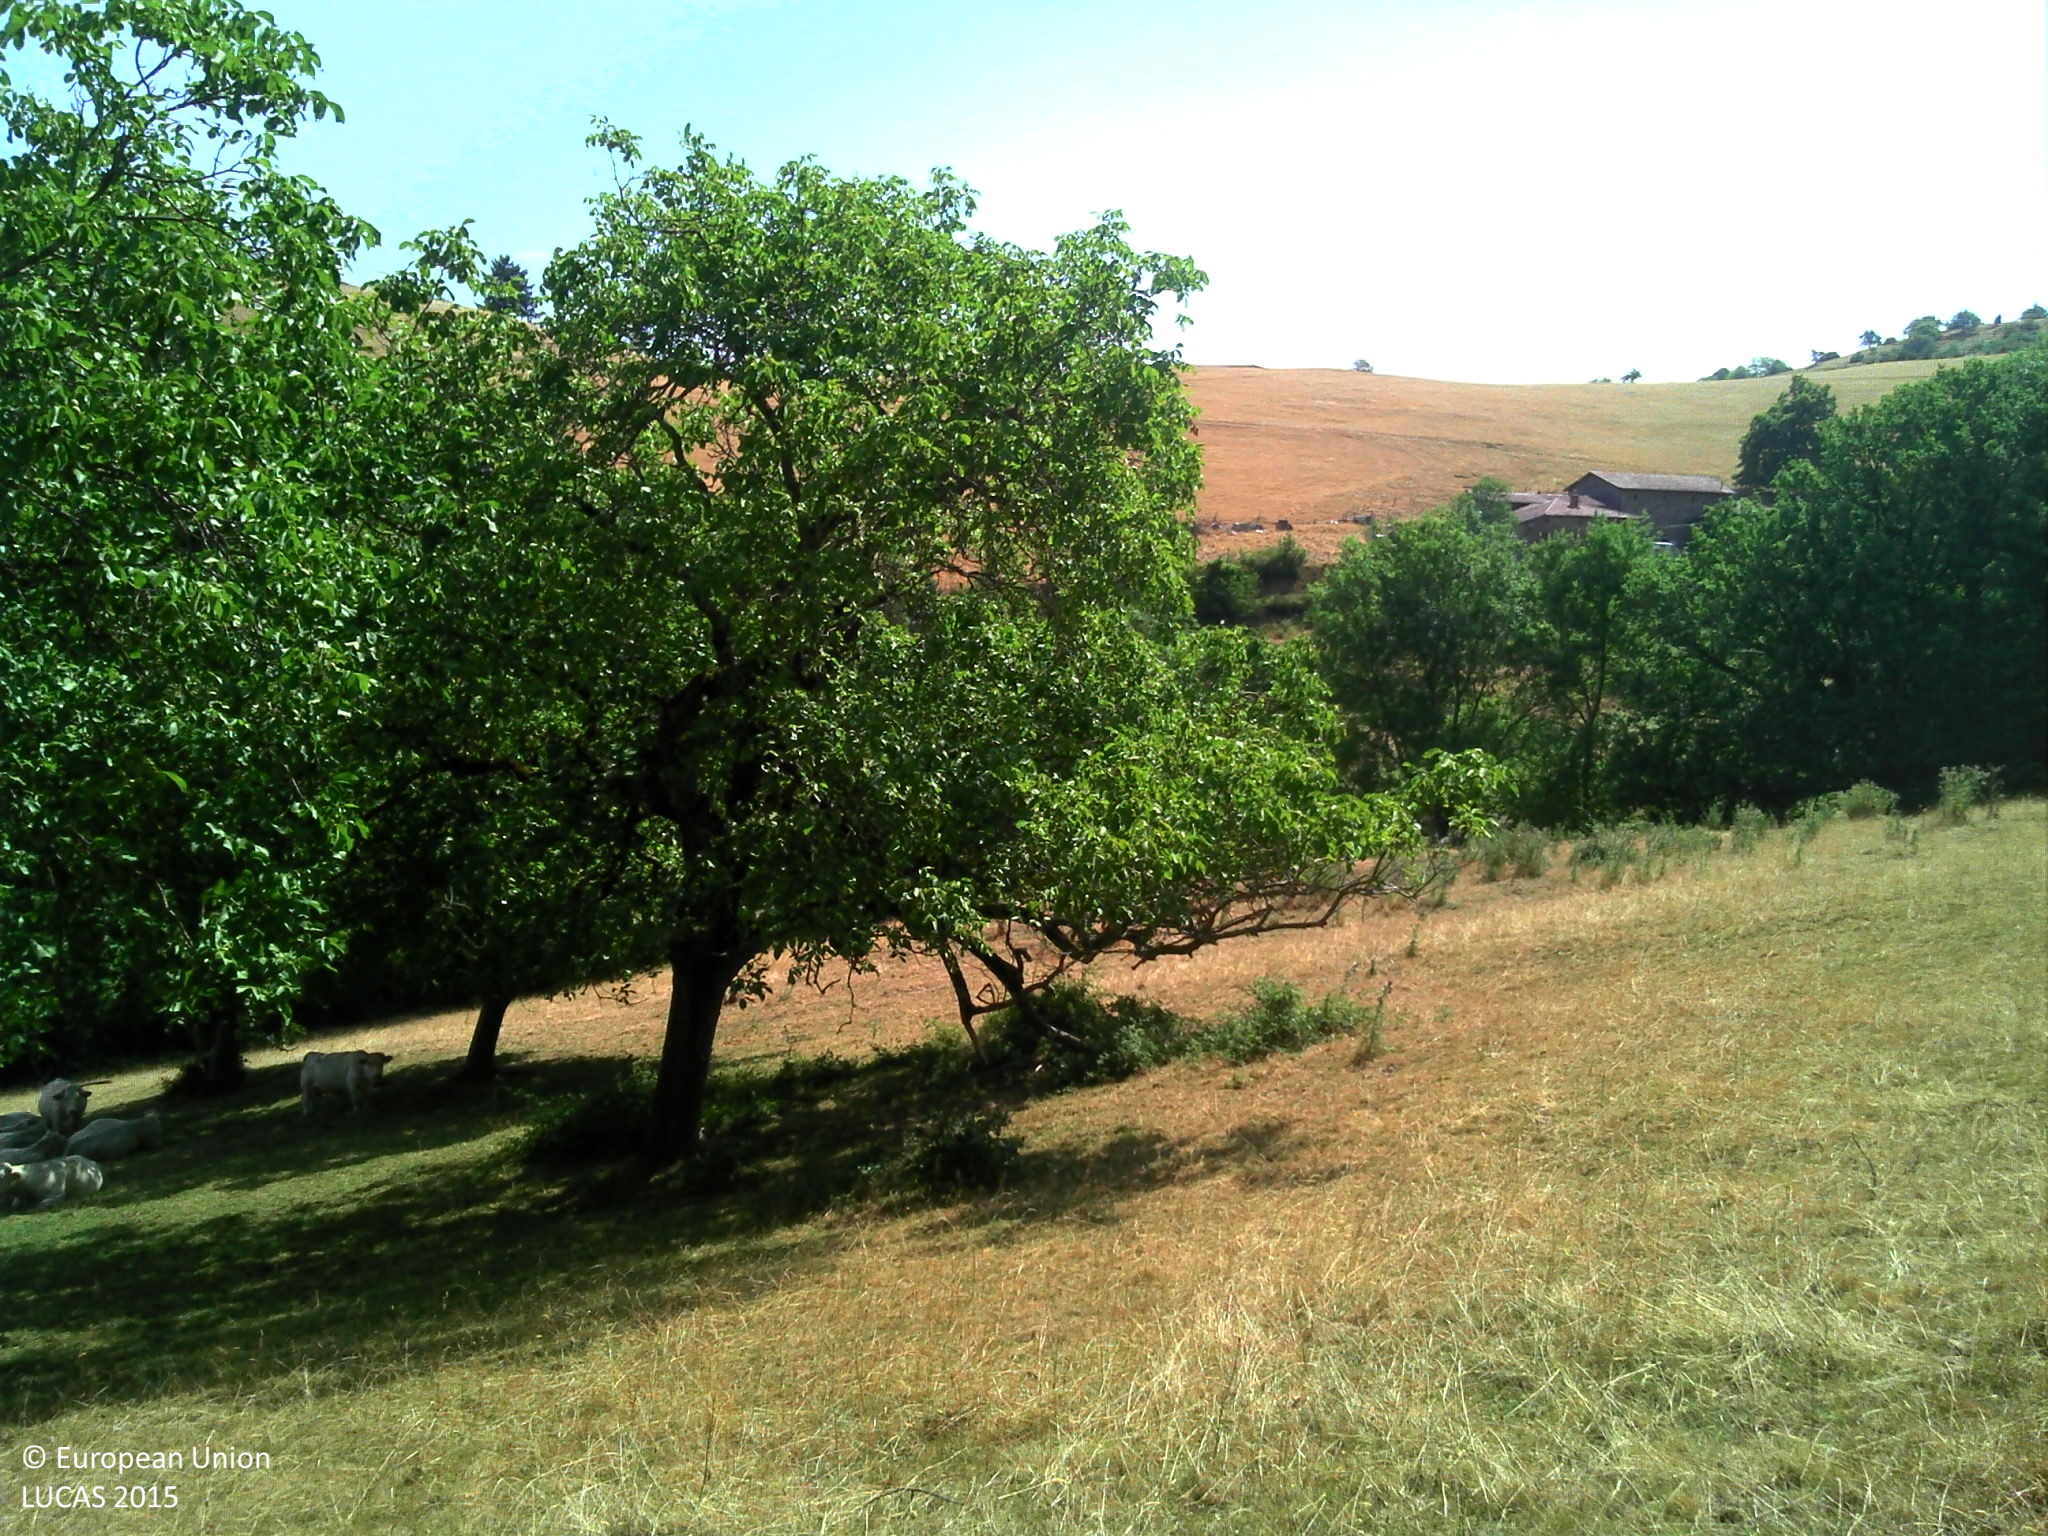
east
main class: Grassland
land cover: Grassland with sparse tree/shrub cover
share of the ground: > 75 %
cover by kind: herbaceous plants 90 %, broadleaved forest trees 5 %, shrubs 5 %
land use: Agriculture (excluding fallow land and kitchen gardens)
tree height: < 5 m
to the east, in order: Grassland with sparse tree/shrub cover; Fences; Broadleaved woodland; Grassland with sparse tree/shrub cover; Fences; Abandoned hedges; Grass margins; Paved roads, cycling and walking lanes; Grass margins; Electric lines; Managed hedges; Fences; Grassland without tree/shrub cover
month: July
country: FR
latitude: 45.9180
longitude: 4.4456
